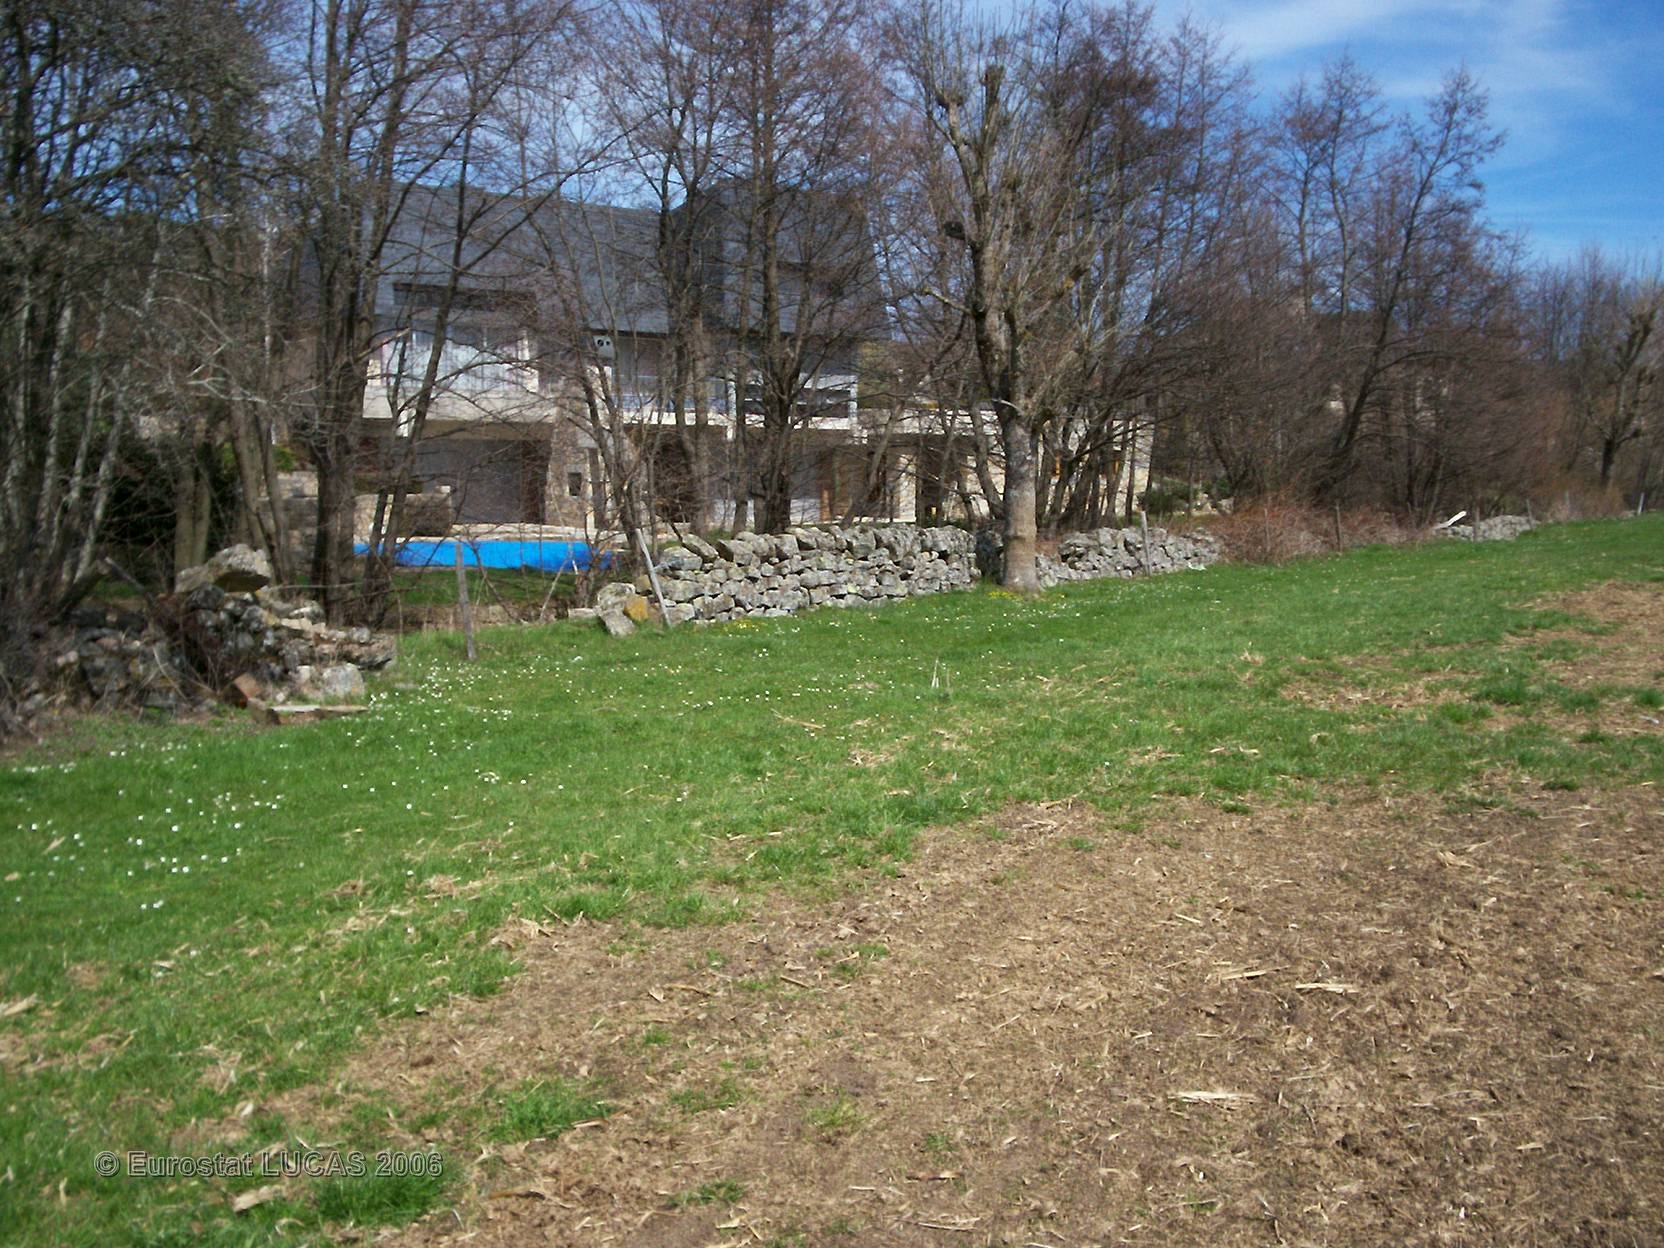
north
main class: Grassland
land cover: Grassland without tree/shrub cover
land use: Agriculture (excluding fallow land and kitchen gardens)
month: April
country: FR
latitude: 44.8597
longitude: 3.3344
